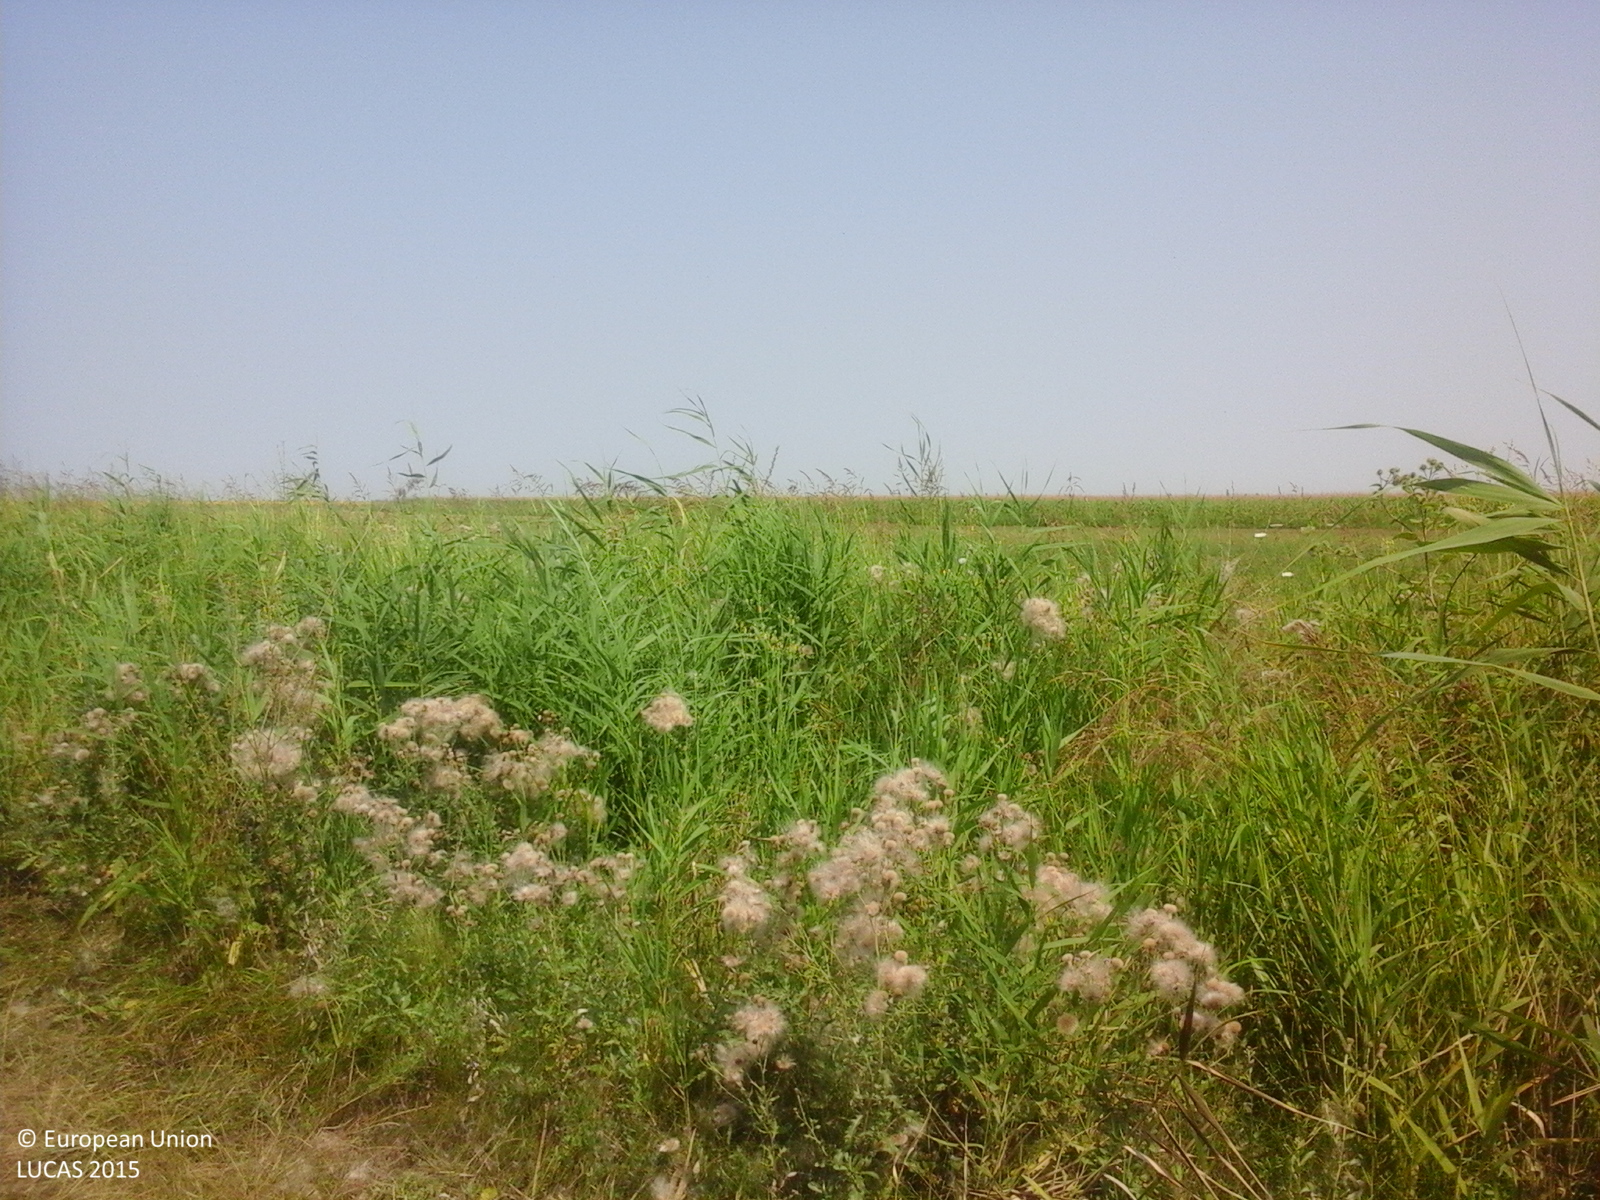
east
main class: Cropland
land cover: Maize
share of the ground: > 75 %
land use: Agriculture (excluding fallow land and kitchen gardens)
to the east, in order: Maize; Tracks; Grass margins; Ditches and canals; Grass margins; Common wheat
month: July
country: RO
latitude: 44.8114
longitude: 26.7789
